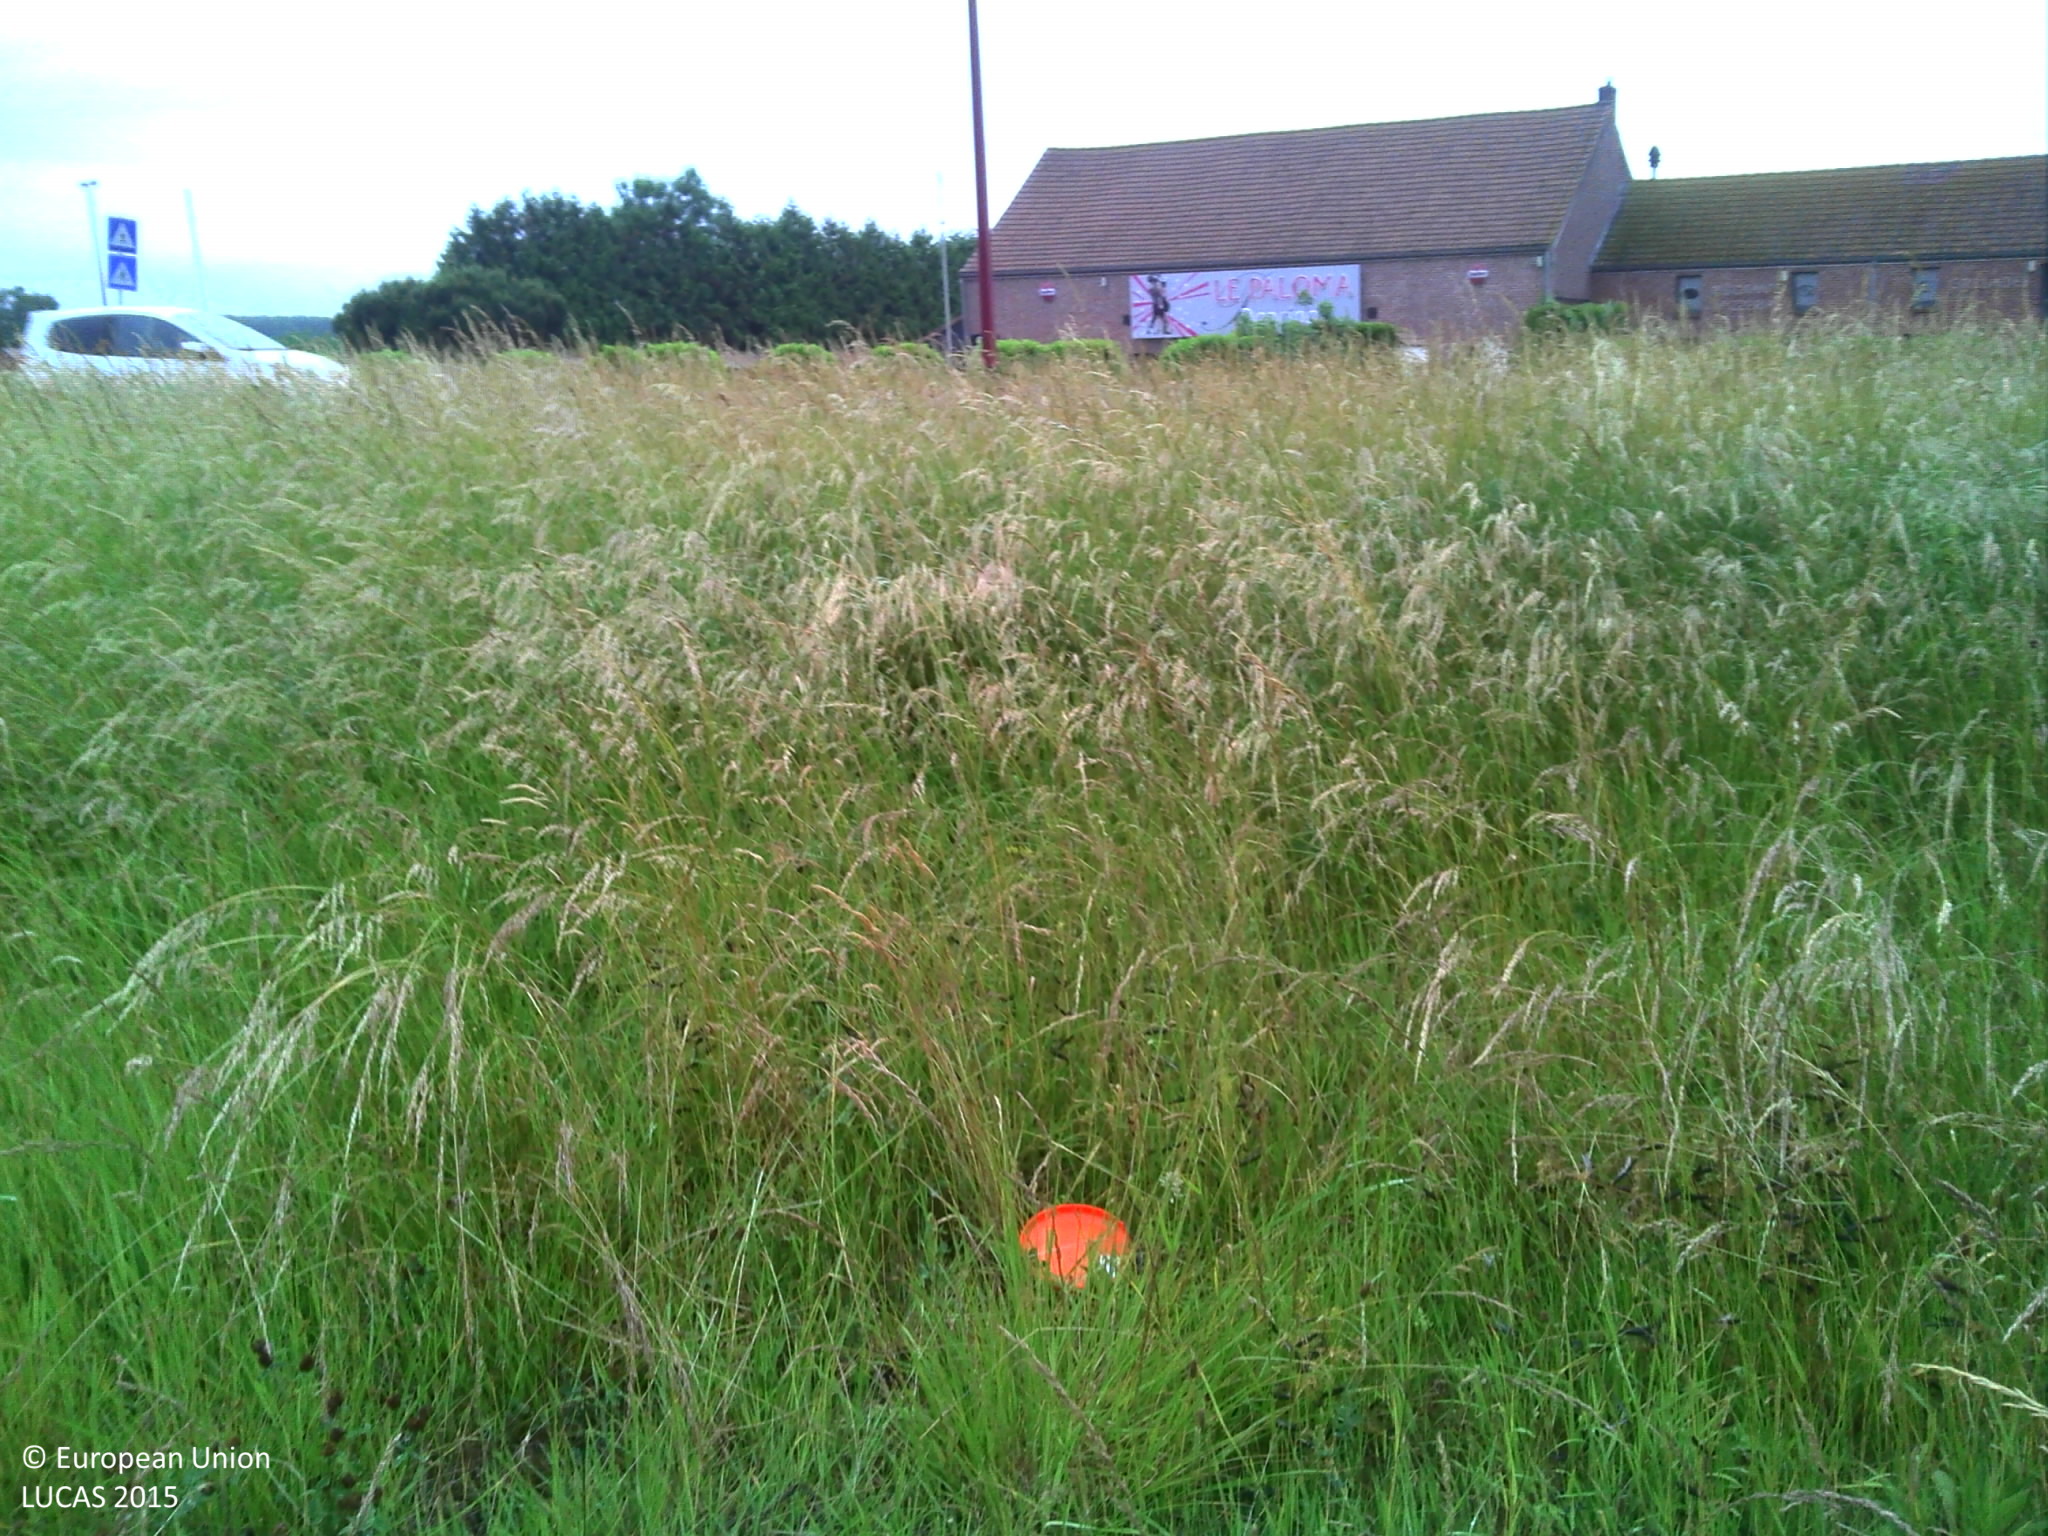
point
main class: Grassland
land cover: Grassland without tree/shrub cover
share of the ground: > 75 %
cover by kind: herbaceous plants 100 %
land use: Semi-natural and natural areas not in use
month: June
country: BE
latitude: 50.4265
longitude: 3.7292
